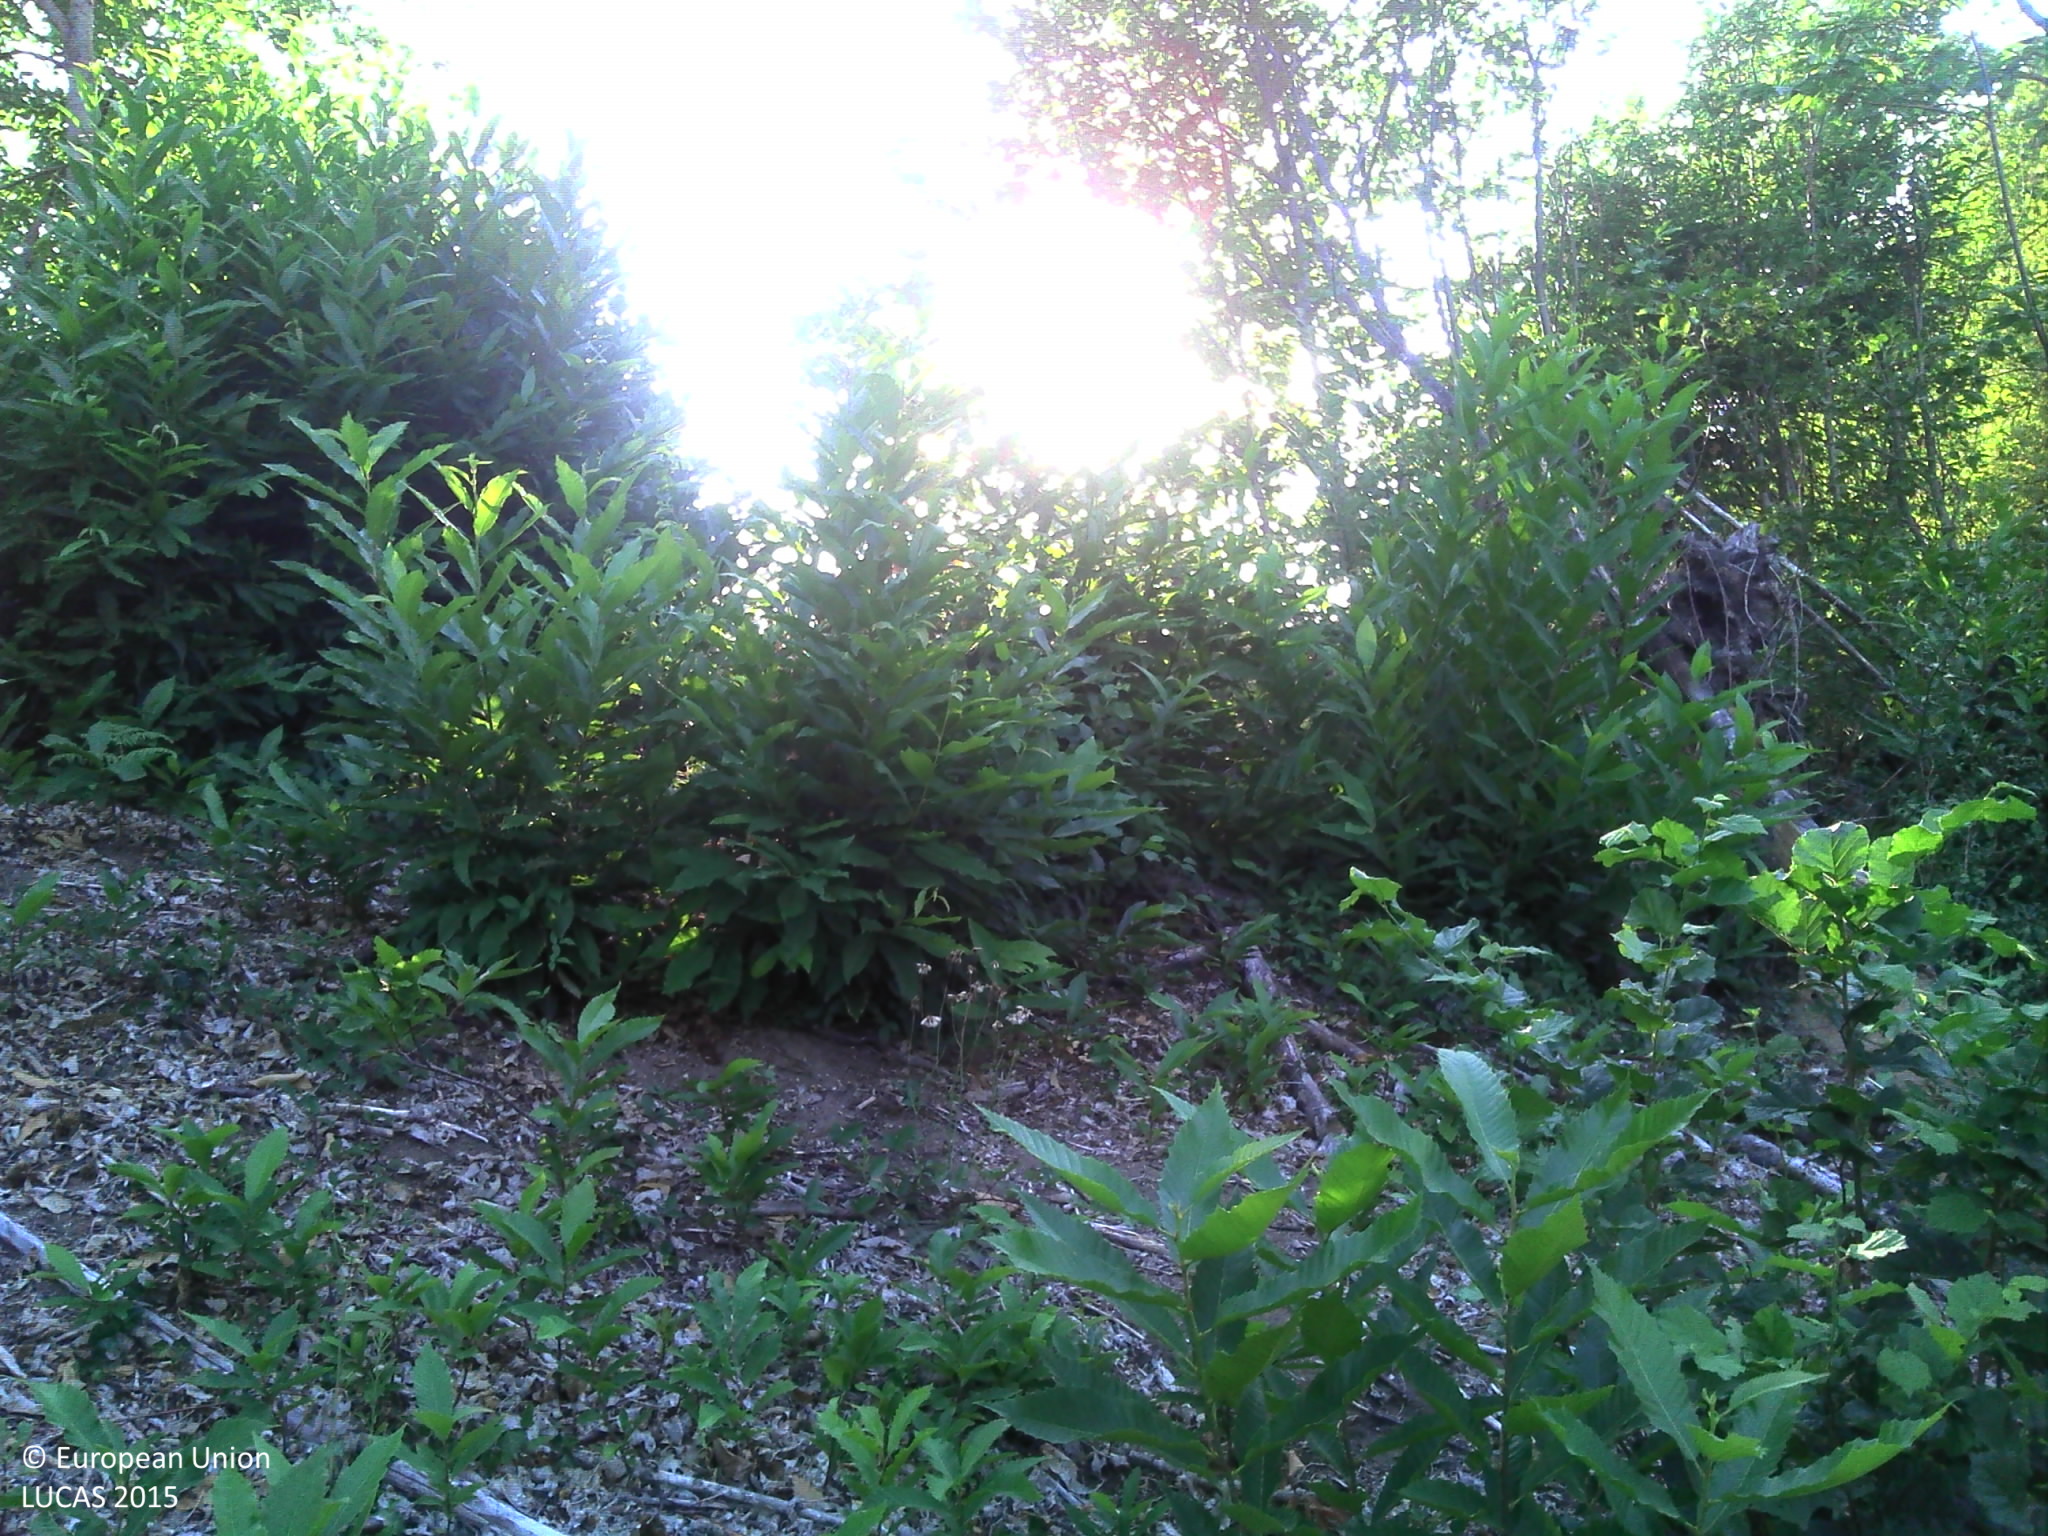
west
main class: Woodland
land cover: Broadleaved woodland
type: thermophilous deciduous forest
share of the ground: 50 - 75 %
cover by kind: broadleaved forest trees 50 %, unconsolidated bare surface 50 %
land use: Forestry
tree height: > 5 m
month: August
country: FR
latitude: 45.3034
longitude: 1.6931
